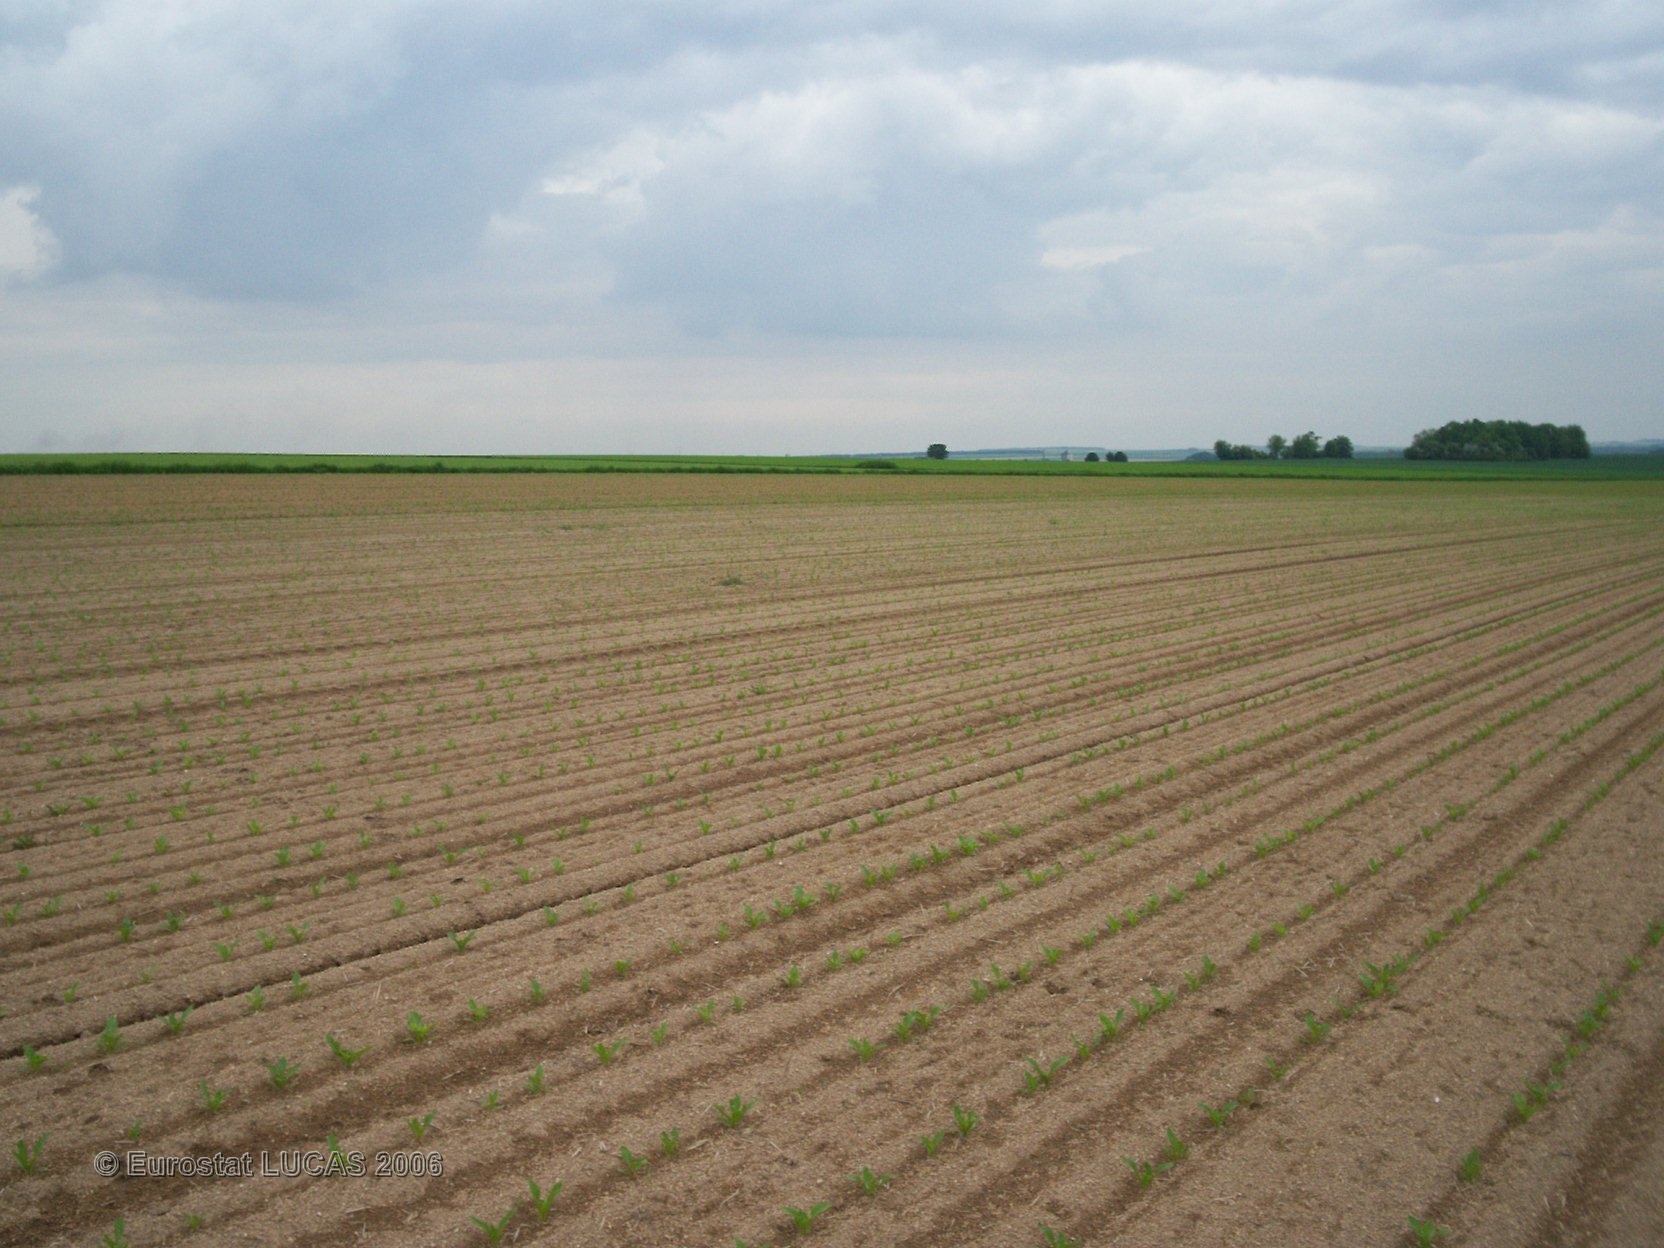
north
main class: Cropland
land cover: Sugar beet
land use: Agriculture (excluding fallow land and kitchen gardens)
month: May
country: FR
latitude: 49.2688
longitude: 4.3475
